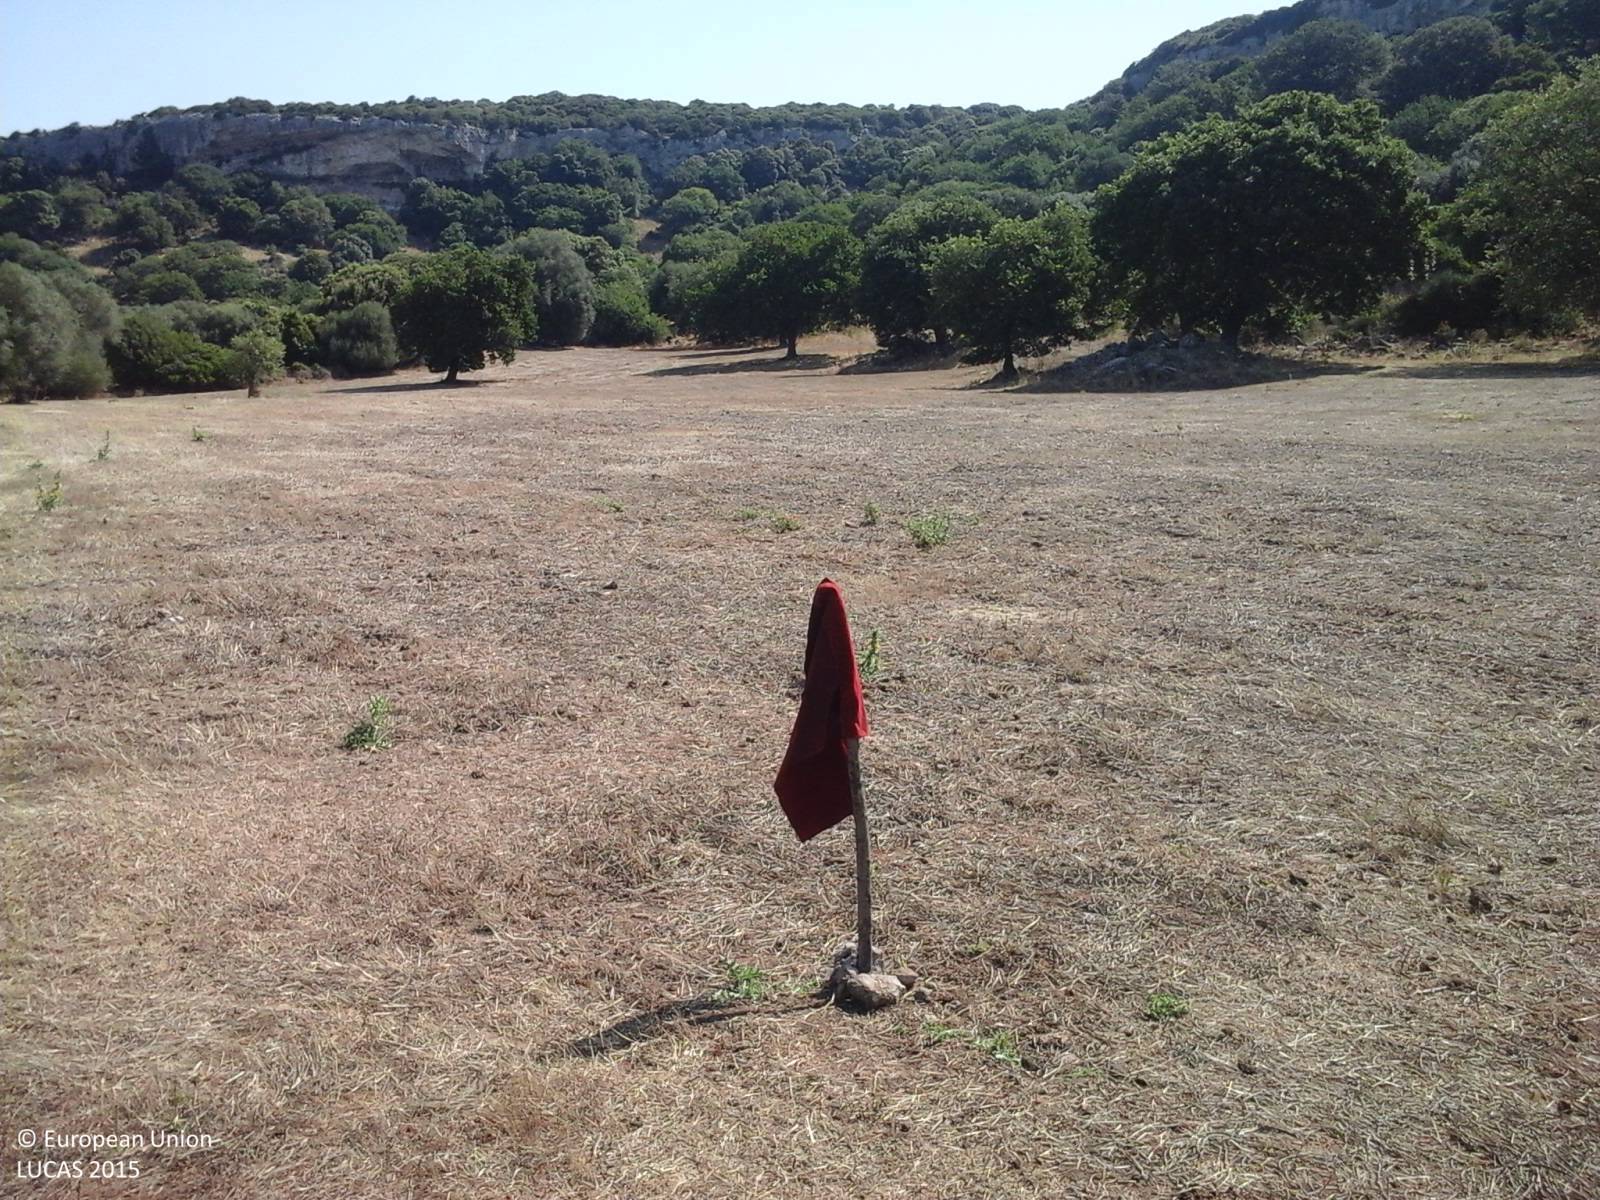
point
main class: Grassland
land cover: Grassland without tree/shrub cover
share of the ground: 50 - 75 %
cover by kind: herbaceous plants 100 %
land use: Agriculture (excluding fallow land and kitchen gardens)
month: July
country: IT
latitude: 40.5108
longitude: 8.6026
